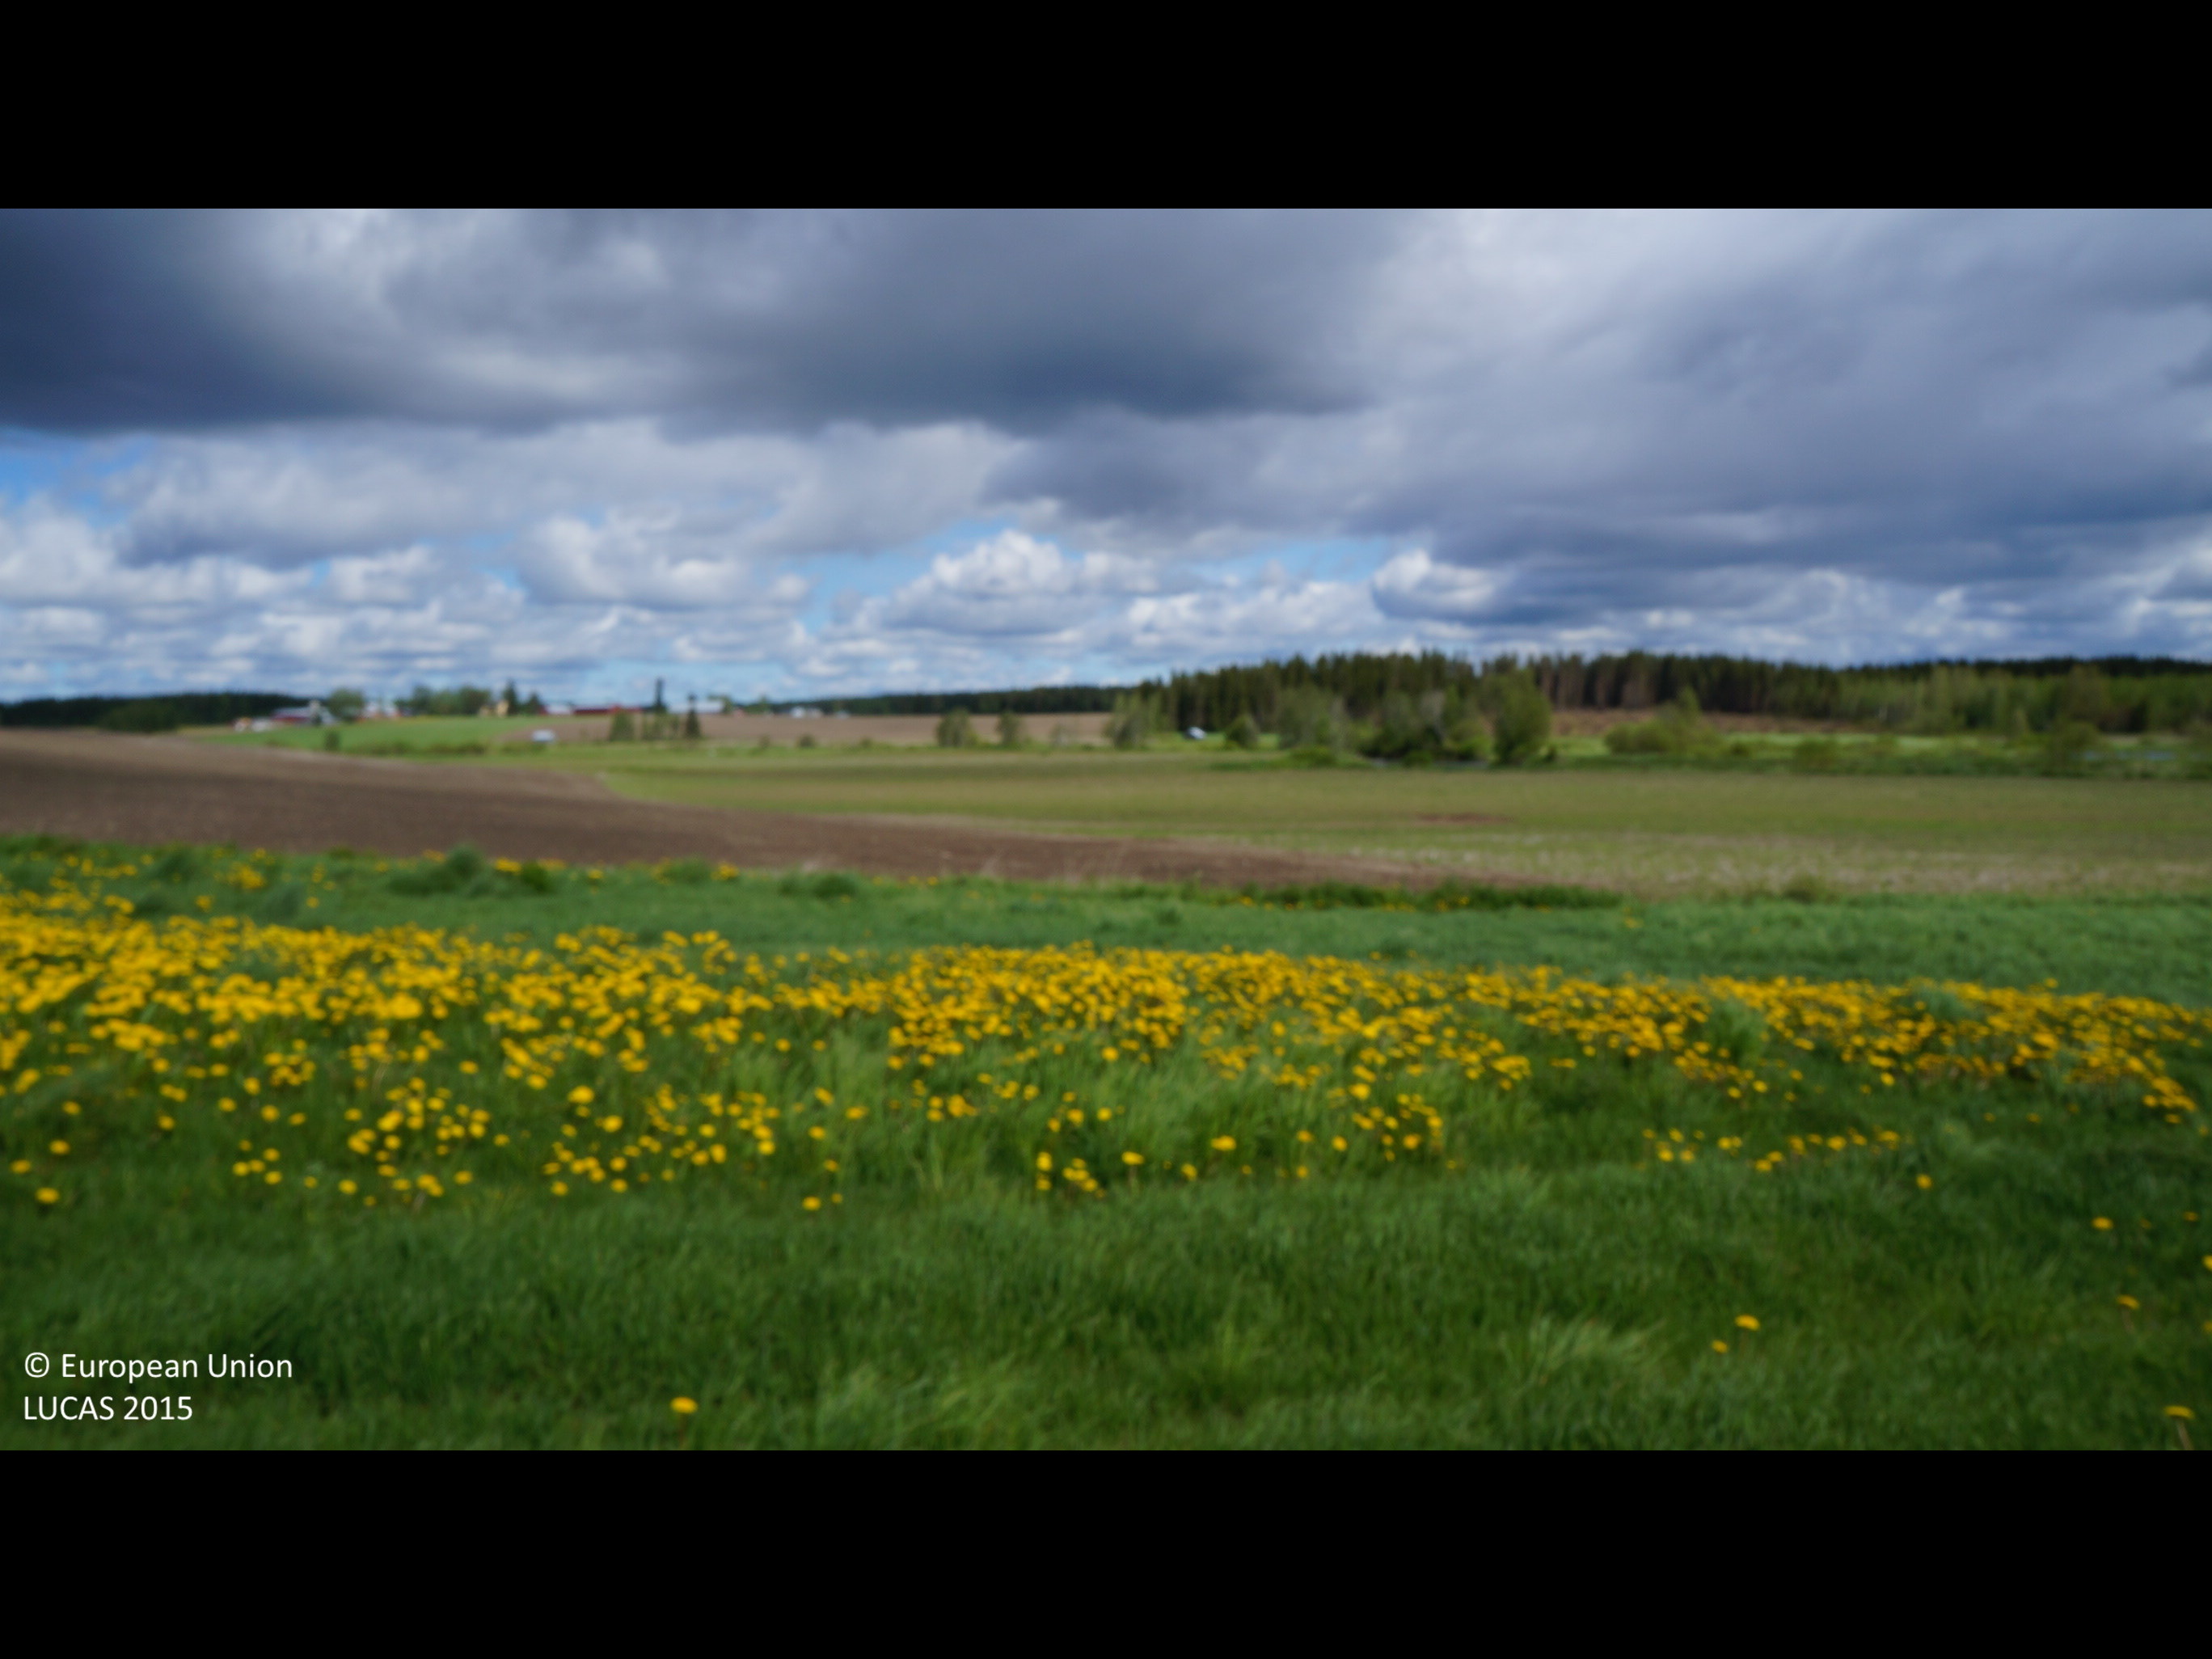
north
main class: Cropland
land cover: Temporary grasslands
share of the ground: > 75 %
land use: Agriculture (excluding fallow land and kitchen gardens)
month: June
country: FI
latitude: 63.7657
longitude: 24.2868
